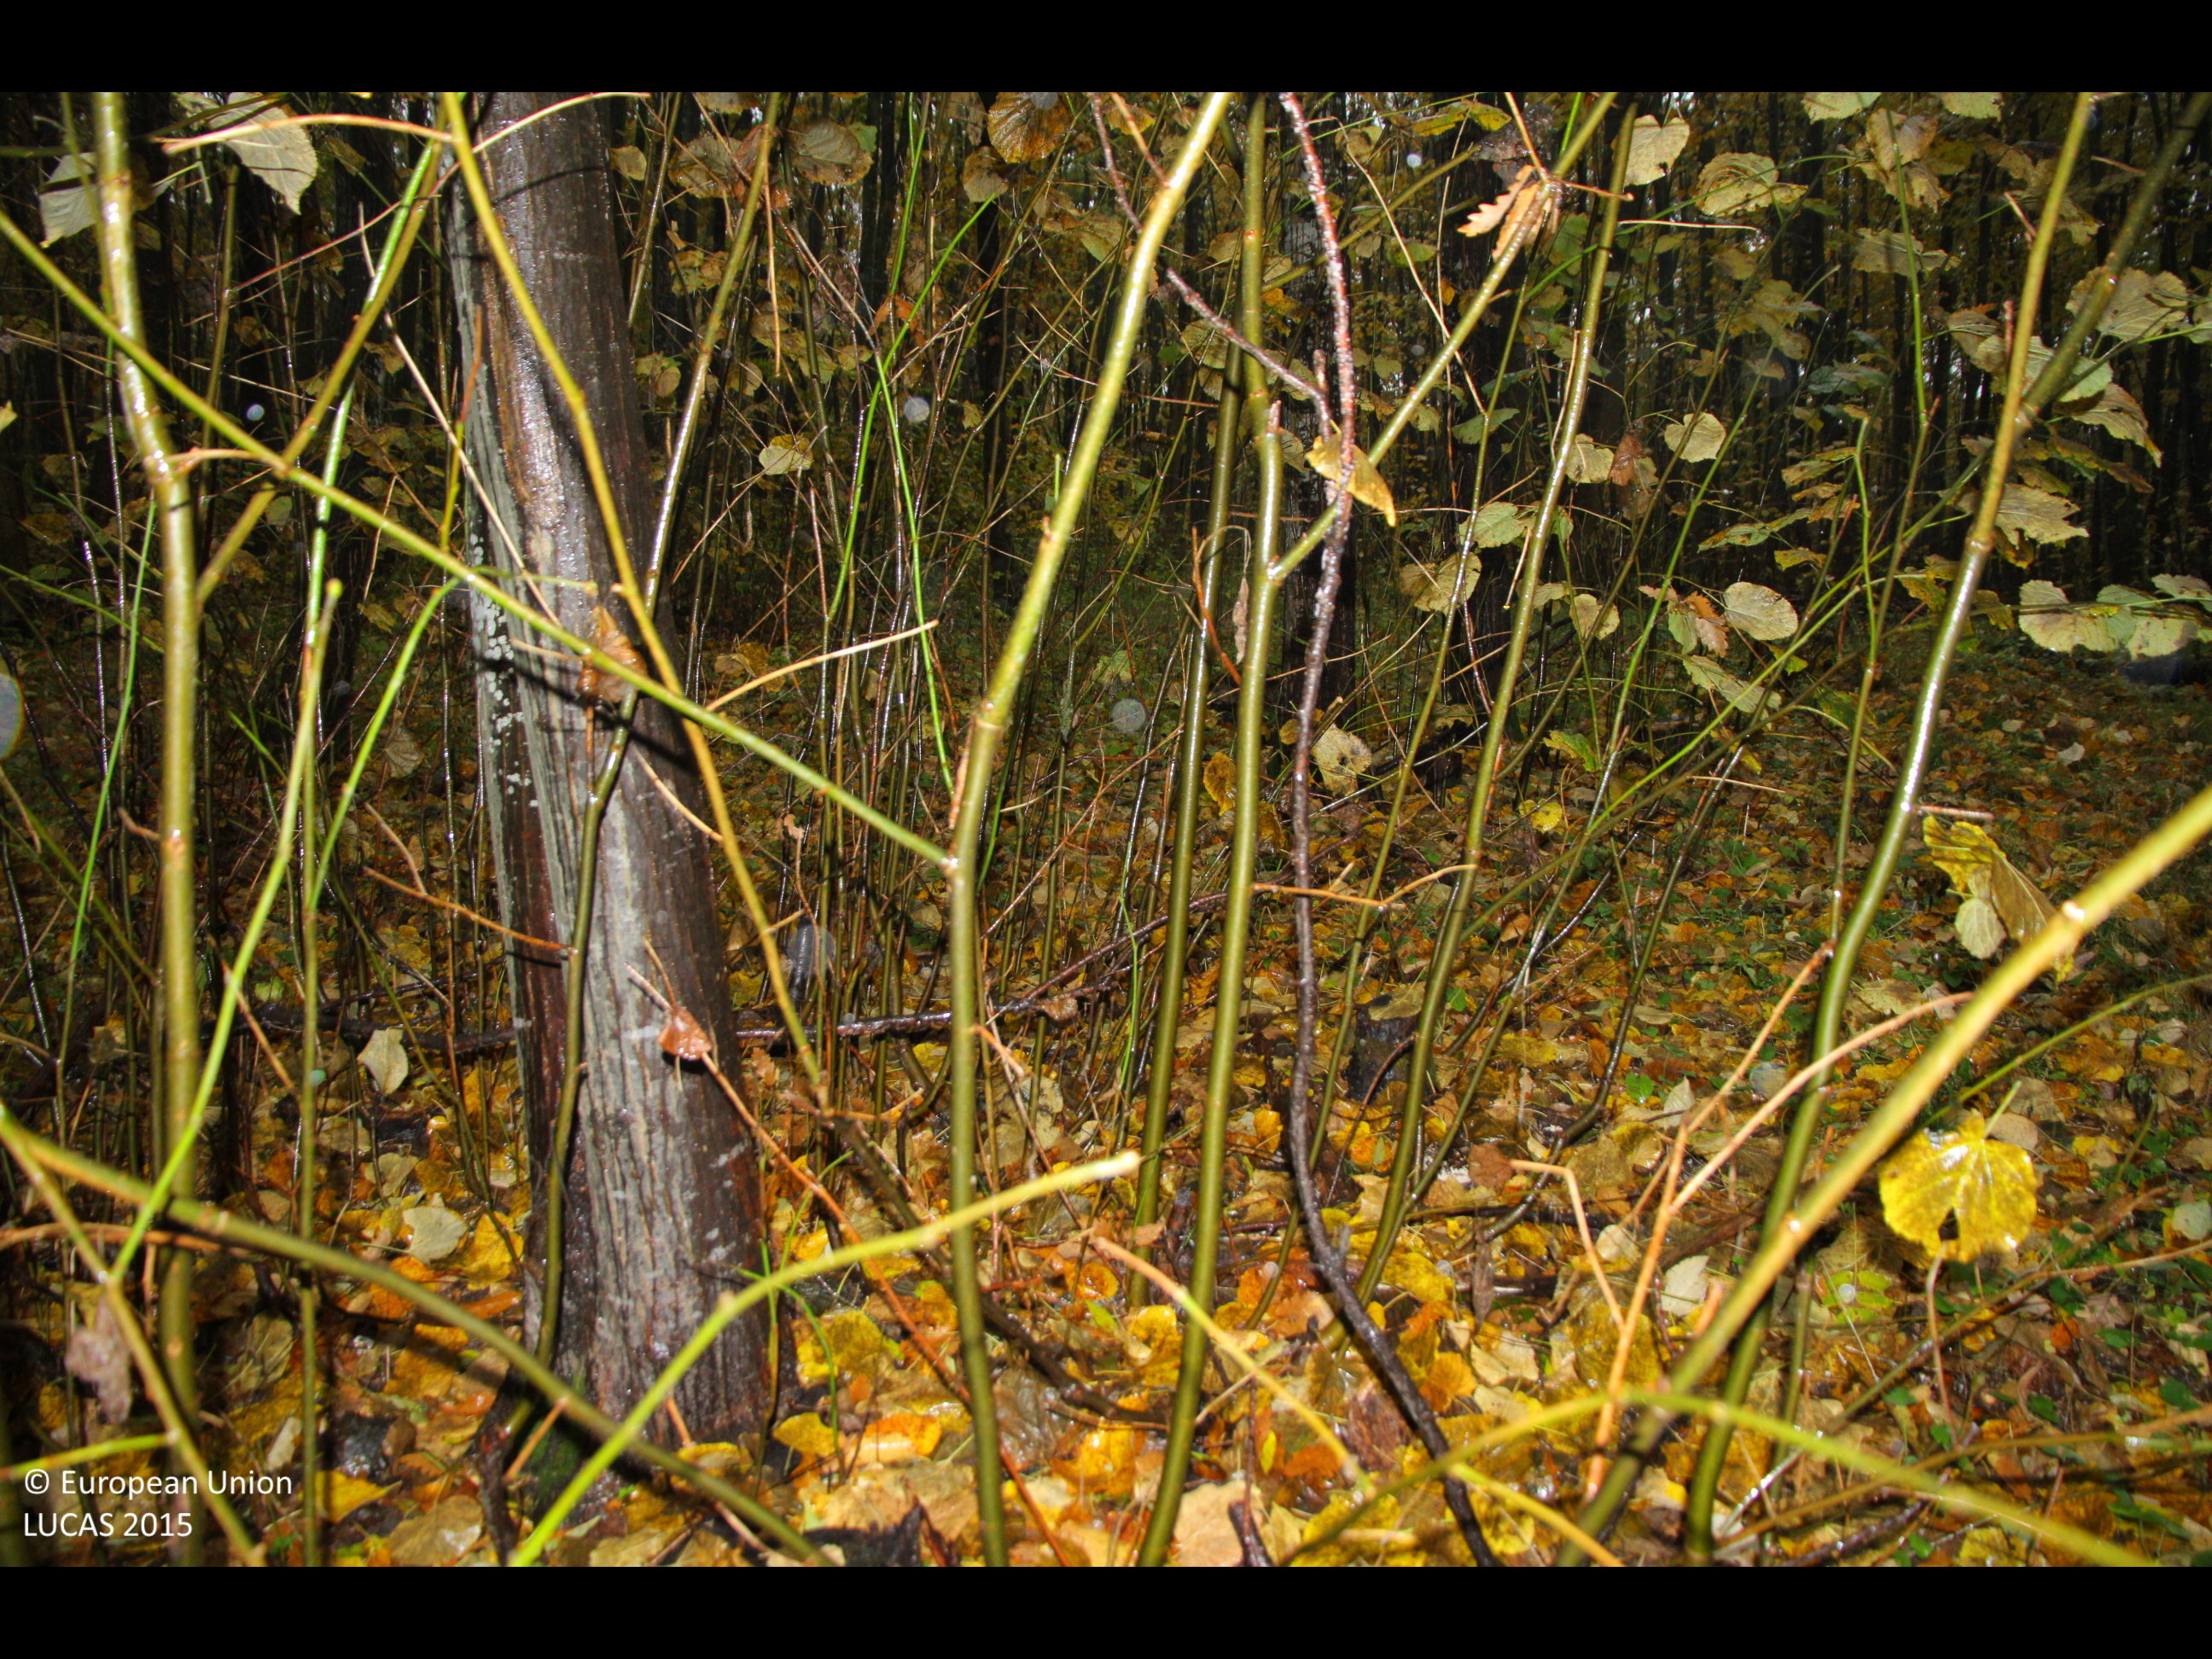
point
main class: Woodland
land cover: Broadleaved woodland
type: beech forest
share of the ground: > 75 %
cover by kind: broadleaved forest trees 100 %
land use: Forestry
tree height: > 5 m
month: October
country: BG
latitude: 43.7595
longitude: 26.4650
